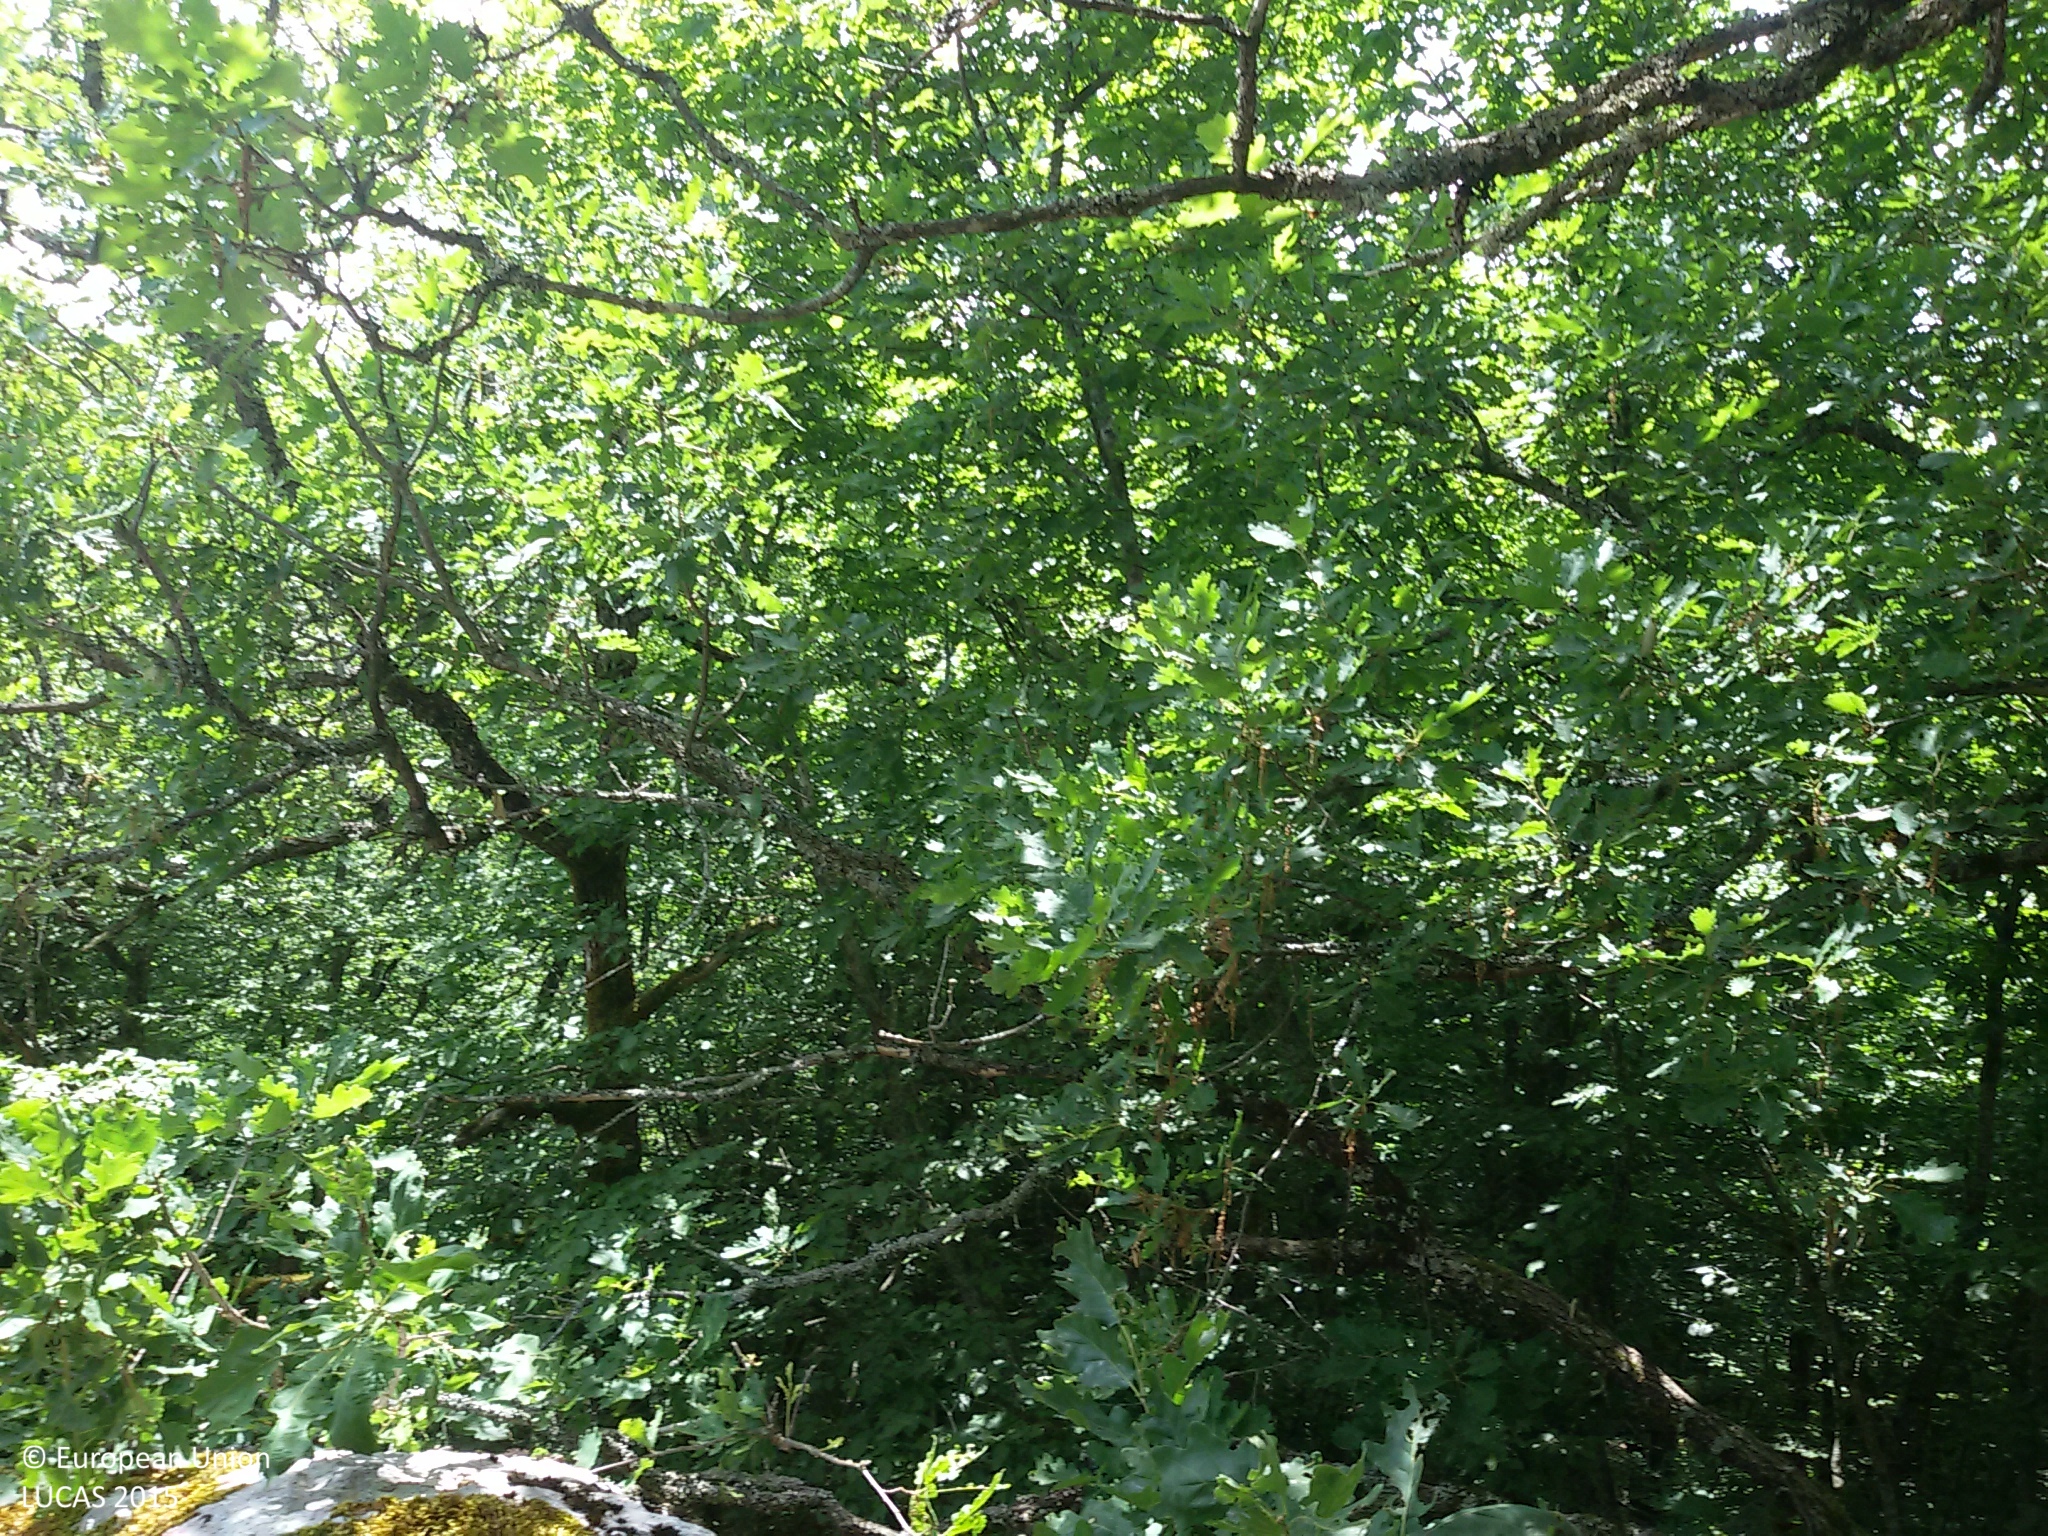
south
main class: Woodland
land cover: Broadleaved woodland
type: acidophilous oak and oak-birch forest
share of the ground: 50 - 75 %
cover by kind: broadleaved forest trees 60 %, lichens and mosses 15 %, shrubs 10 %, consolidated bare surface 10 %, unconsolidated bare surface 5 %
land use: Semi-natural and natural areas not in use
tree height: > 5 m
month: June
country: HR
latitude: 44.5471
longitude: 15.5192
